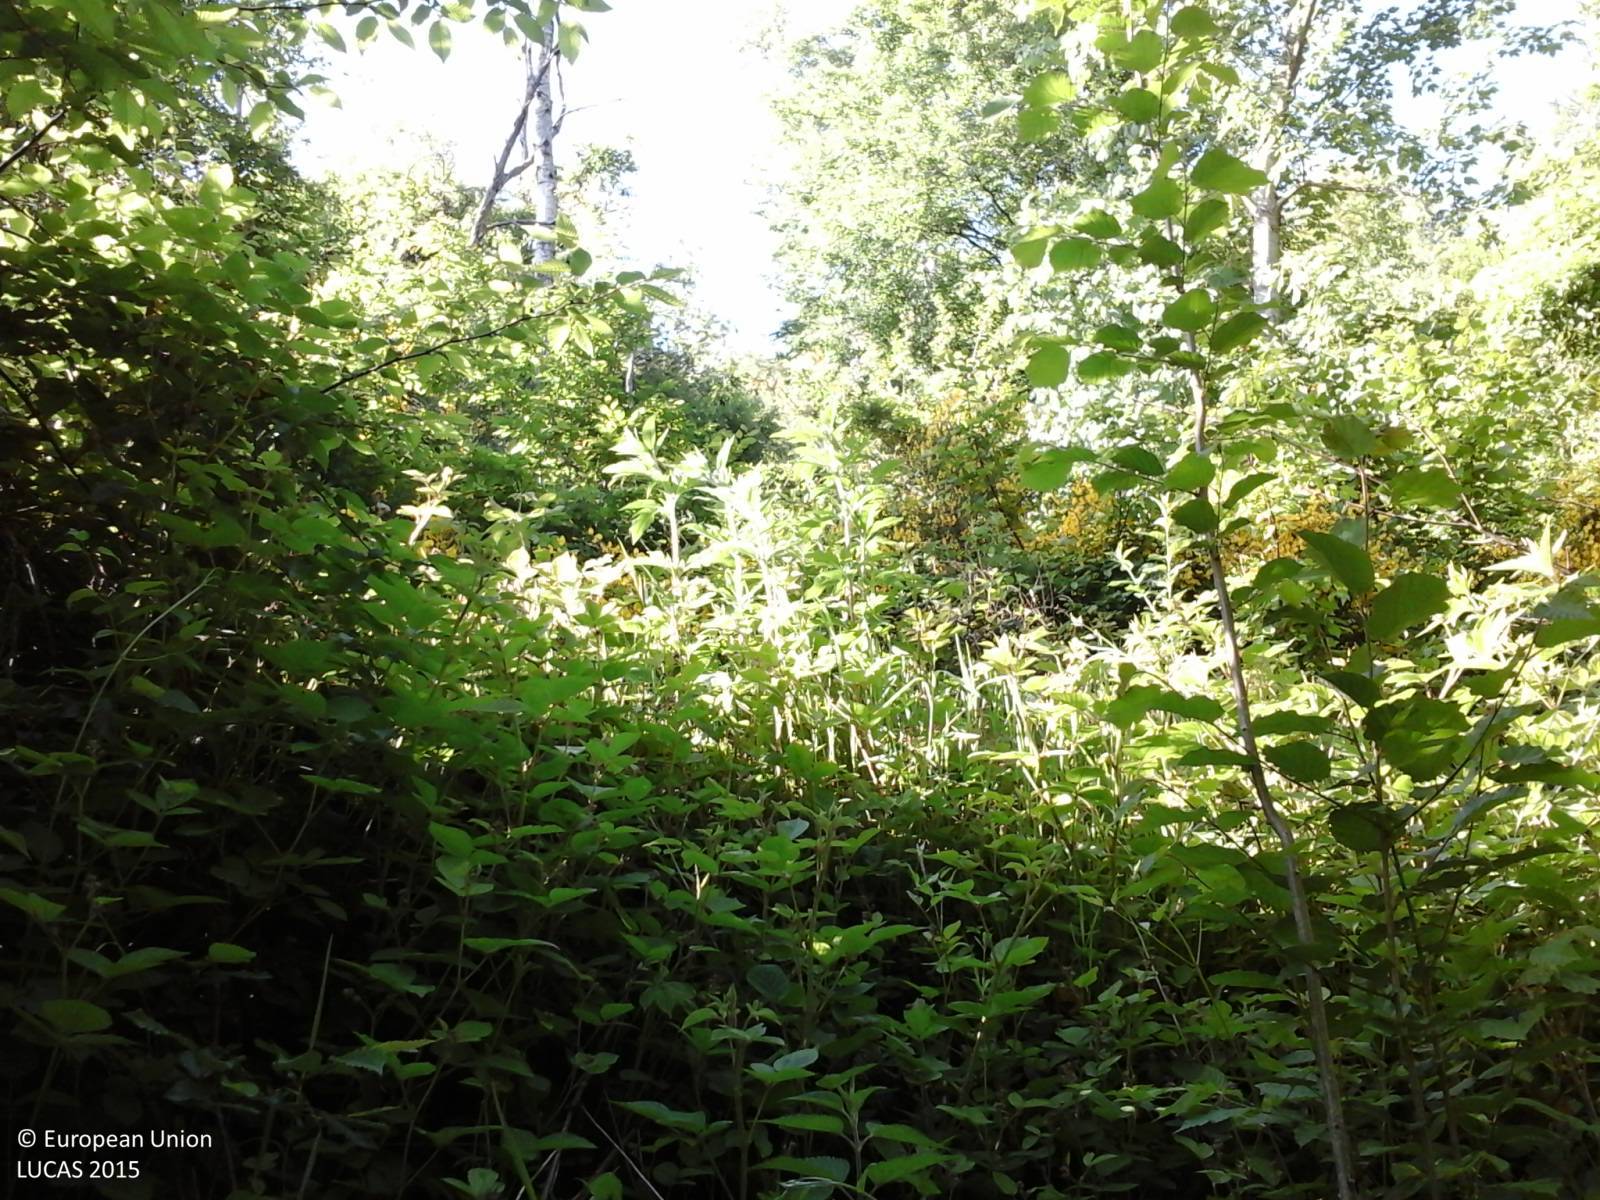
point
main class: Shrubland
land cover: Shrubland with sparse tree cover
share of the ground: > 75 %
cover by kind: shrubs 90 %, broadleaved forest trees 5 %, herbaceous plants 5 %
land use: Semi-natural and natural areas not in use
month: May
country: IT
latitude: 42.1352
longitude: 13.1469
